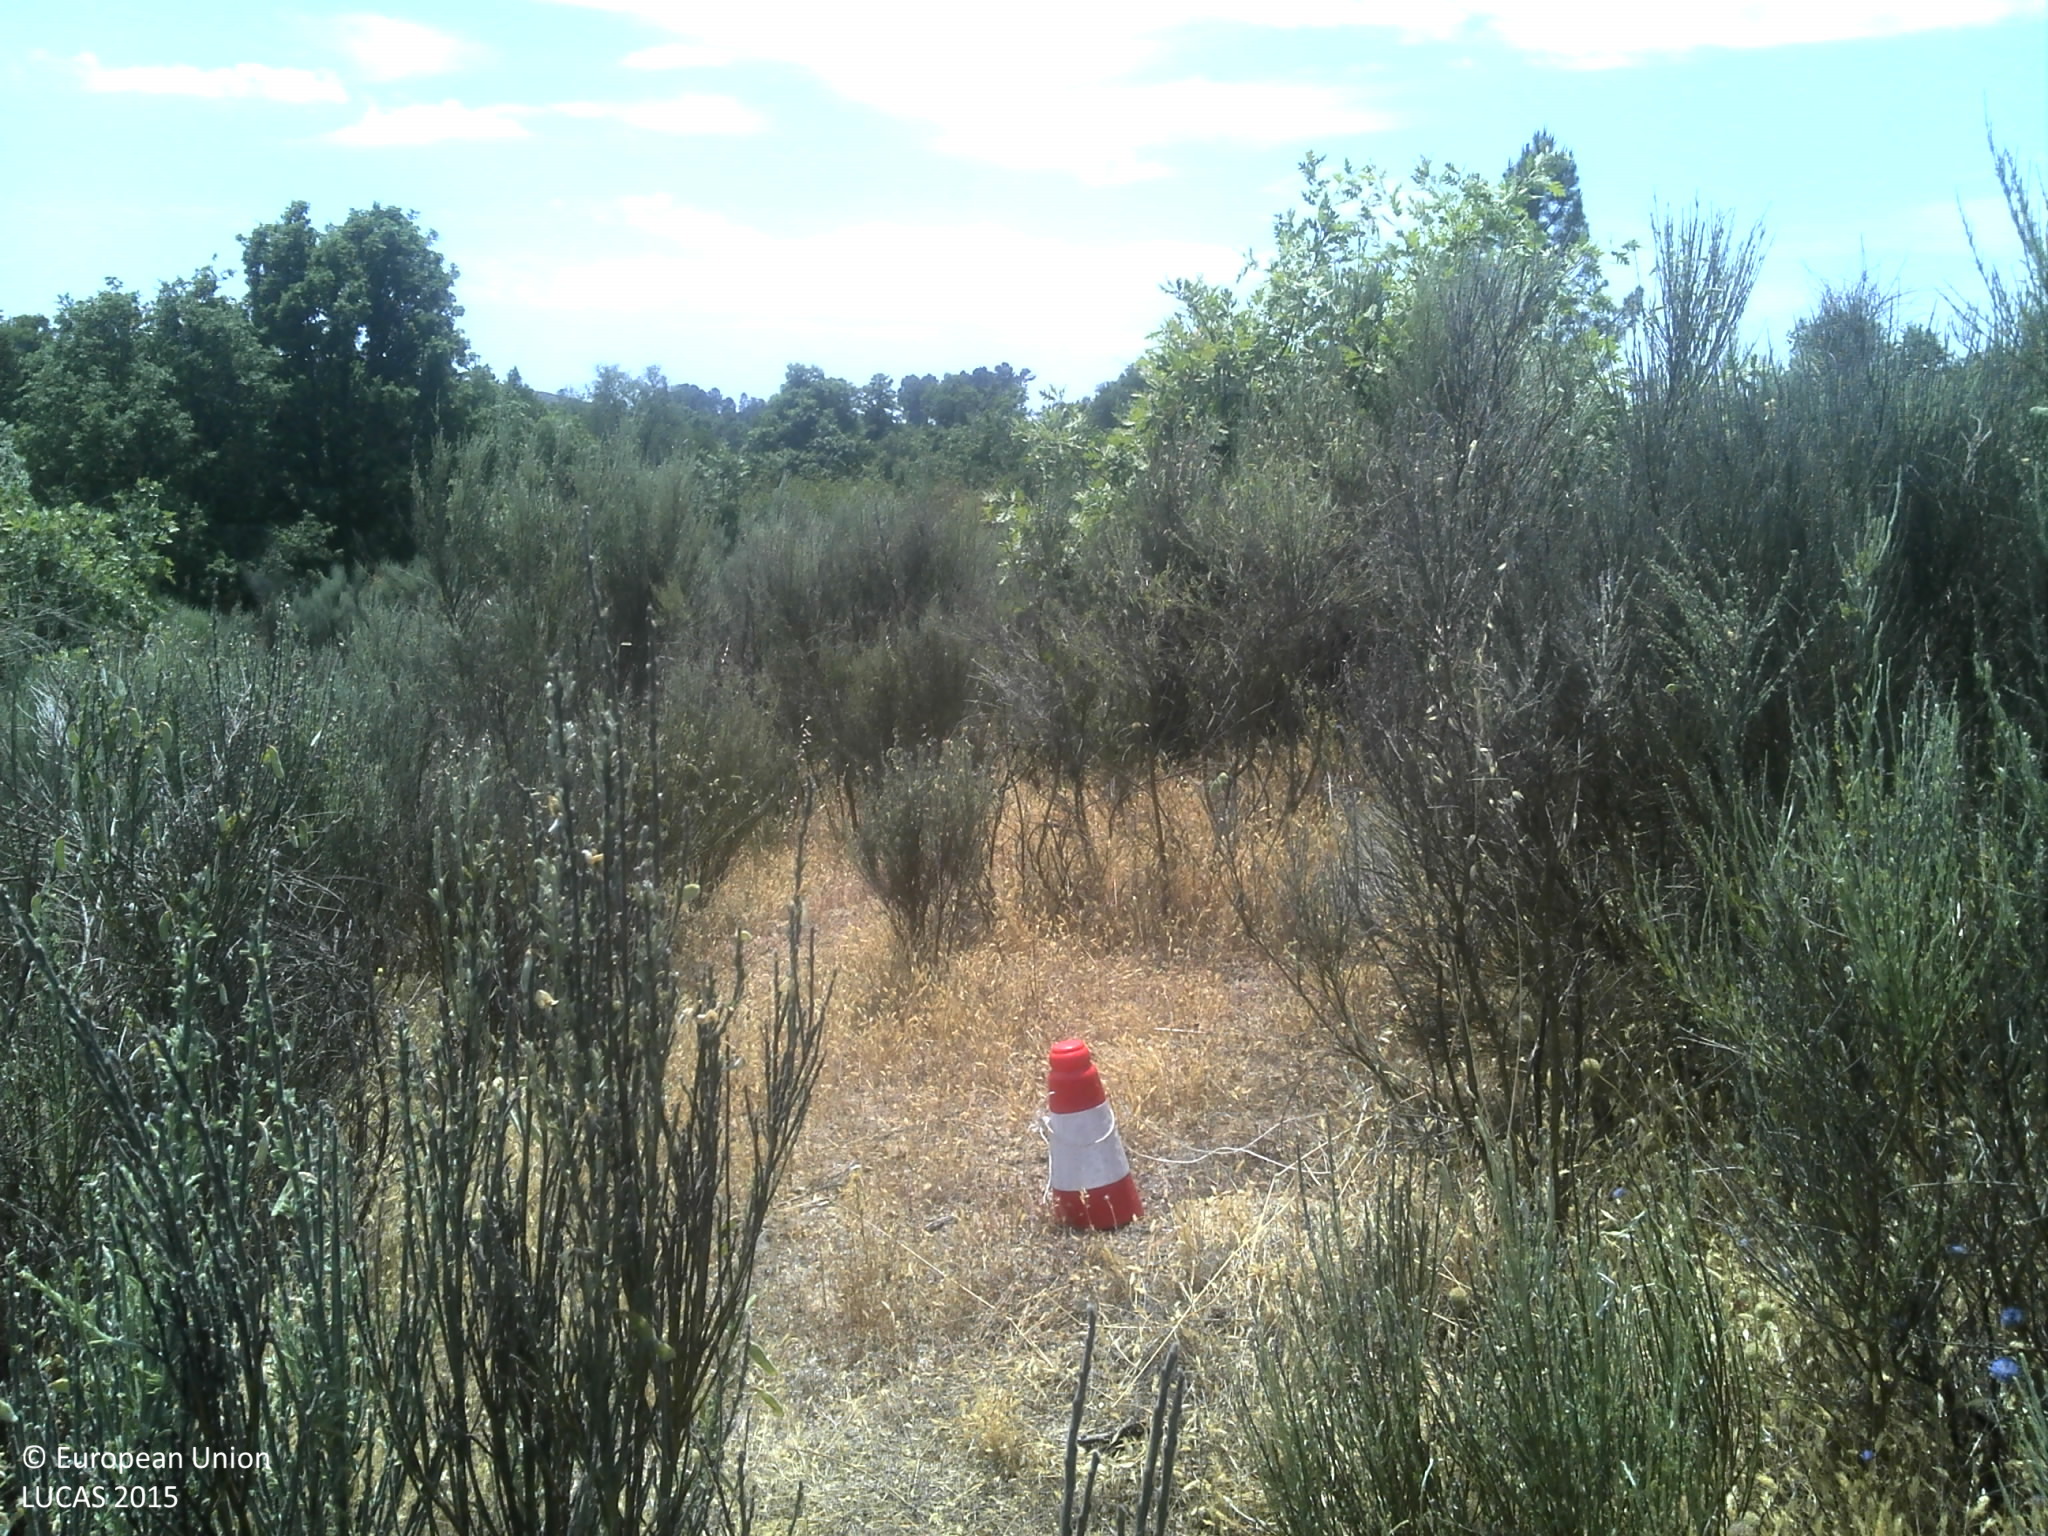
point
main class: Shrubland
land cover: Shrubland without tree cover
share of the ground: > 75 %
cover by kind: shrubs 85 %, unconsolidated bare surface 10 %, herbaceous plants 5 %
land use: Semi-natural and natural areas not in use
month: June
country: PT
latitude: 40.4299
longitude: -7.1096
